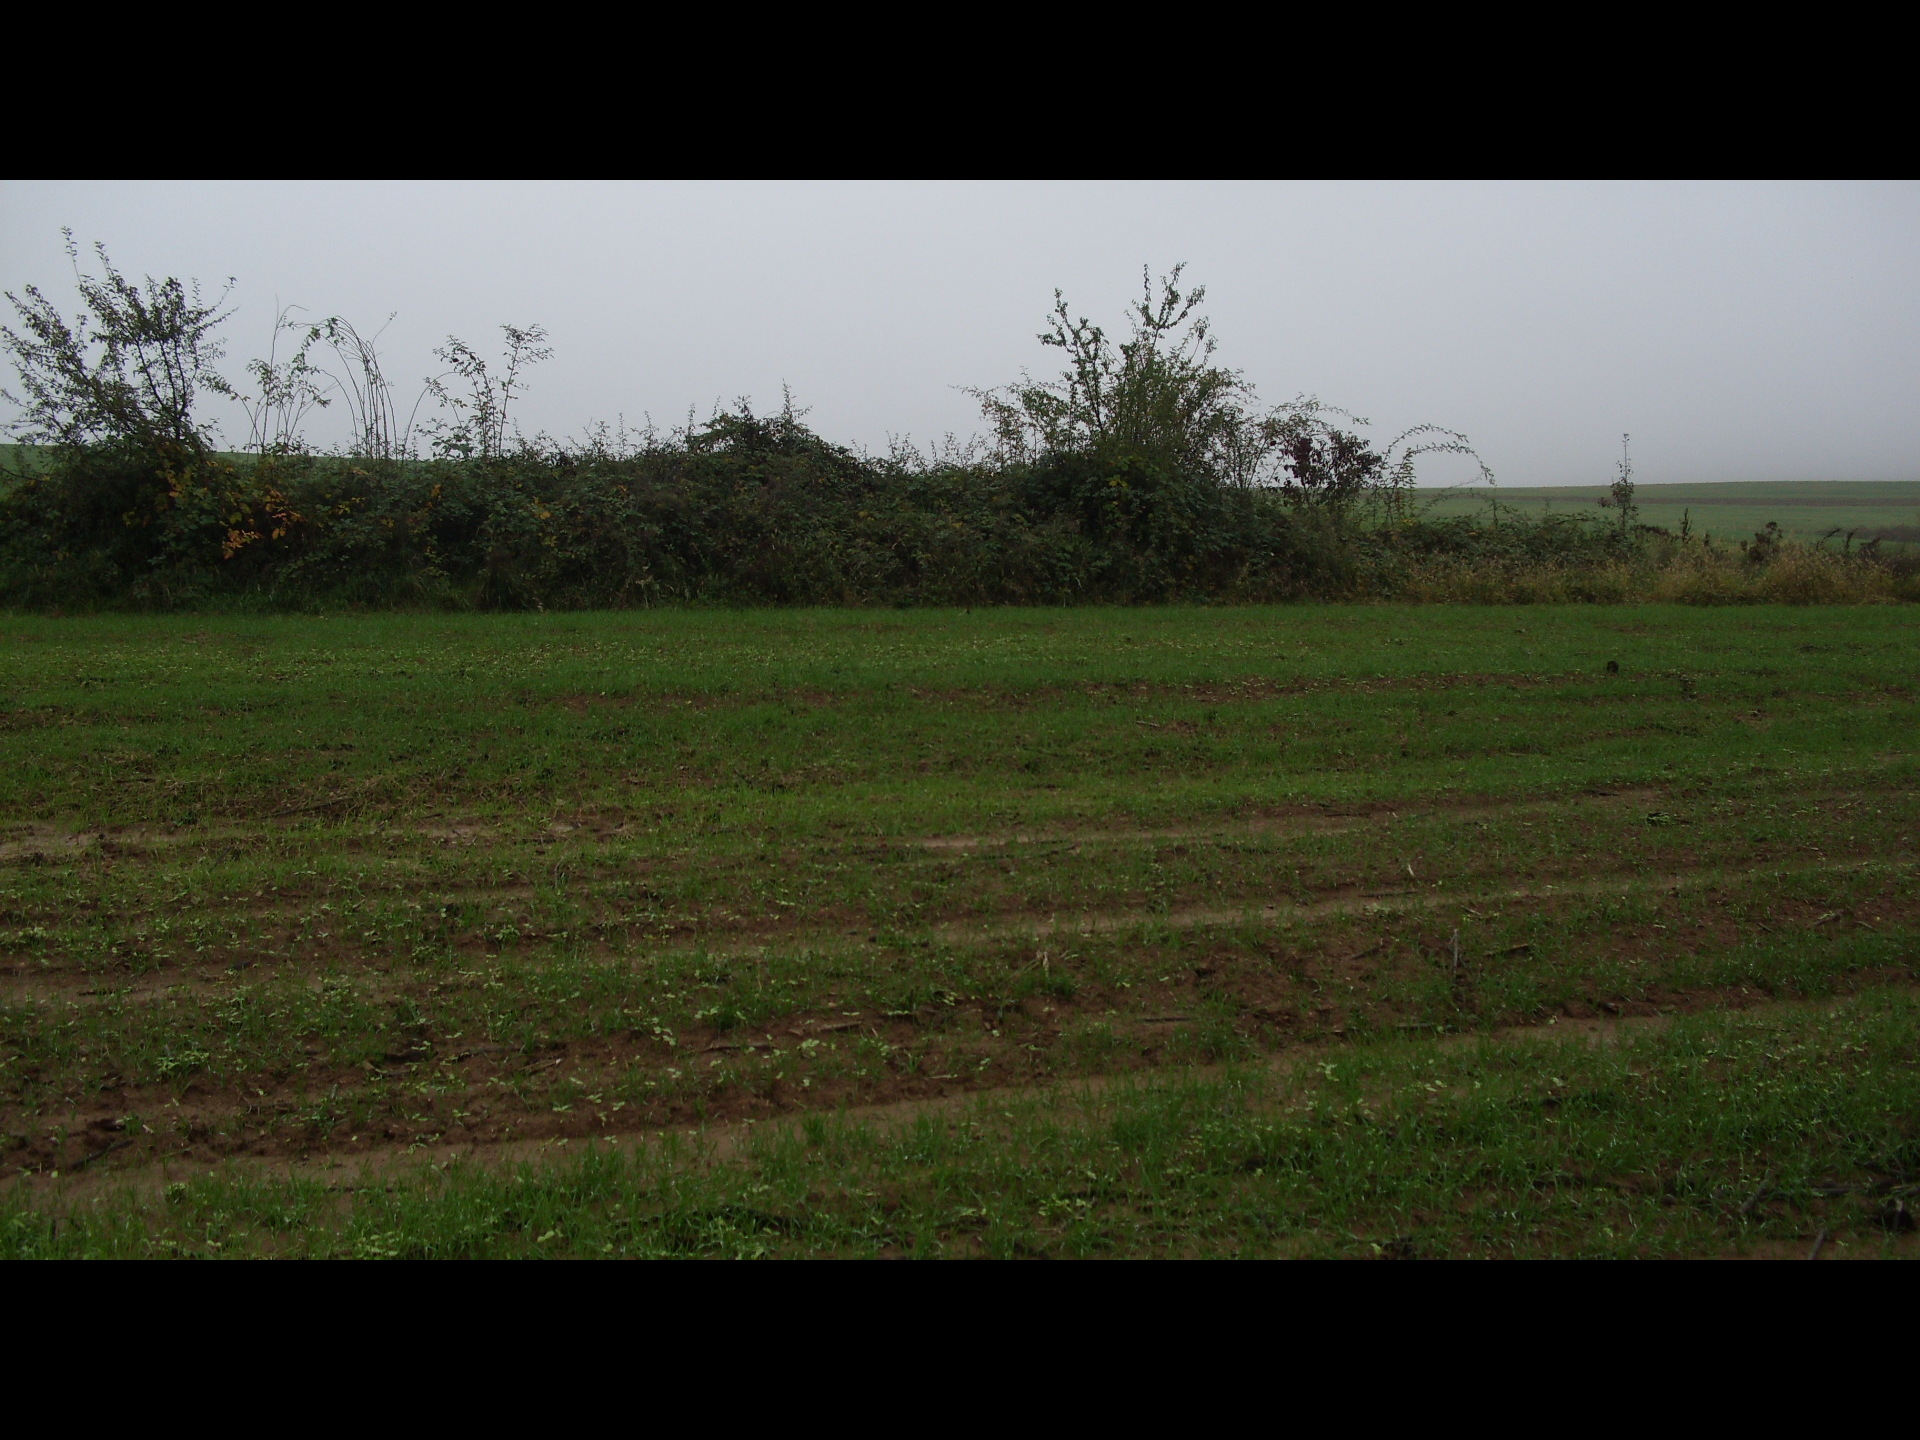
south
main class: Cropland
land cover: Pear fruit
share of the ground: 50 - 75 %
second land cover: Spontaneously vegetated surfaces
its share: > 75 %
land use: Abandoned areas
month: October
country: BG
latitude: 43.5484
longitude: 22.8460
